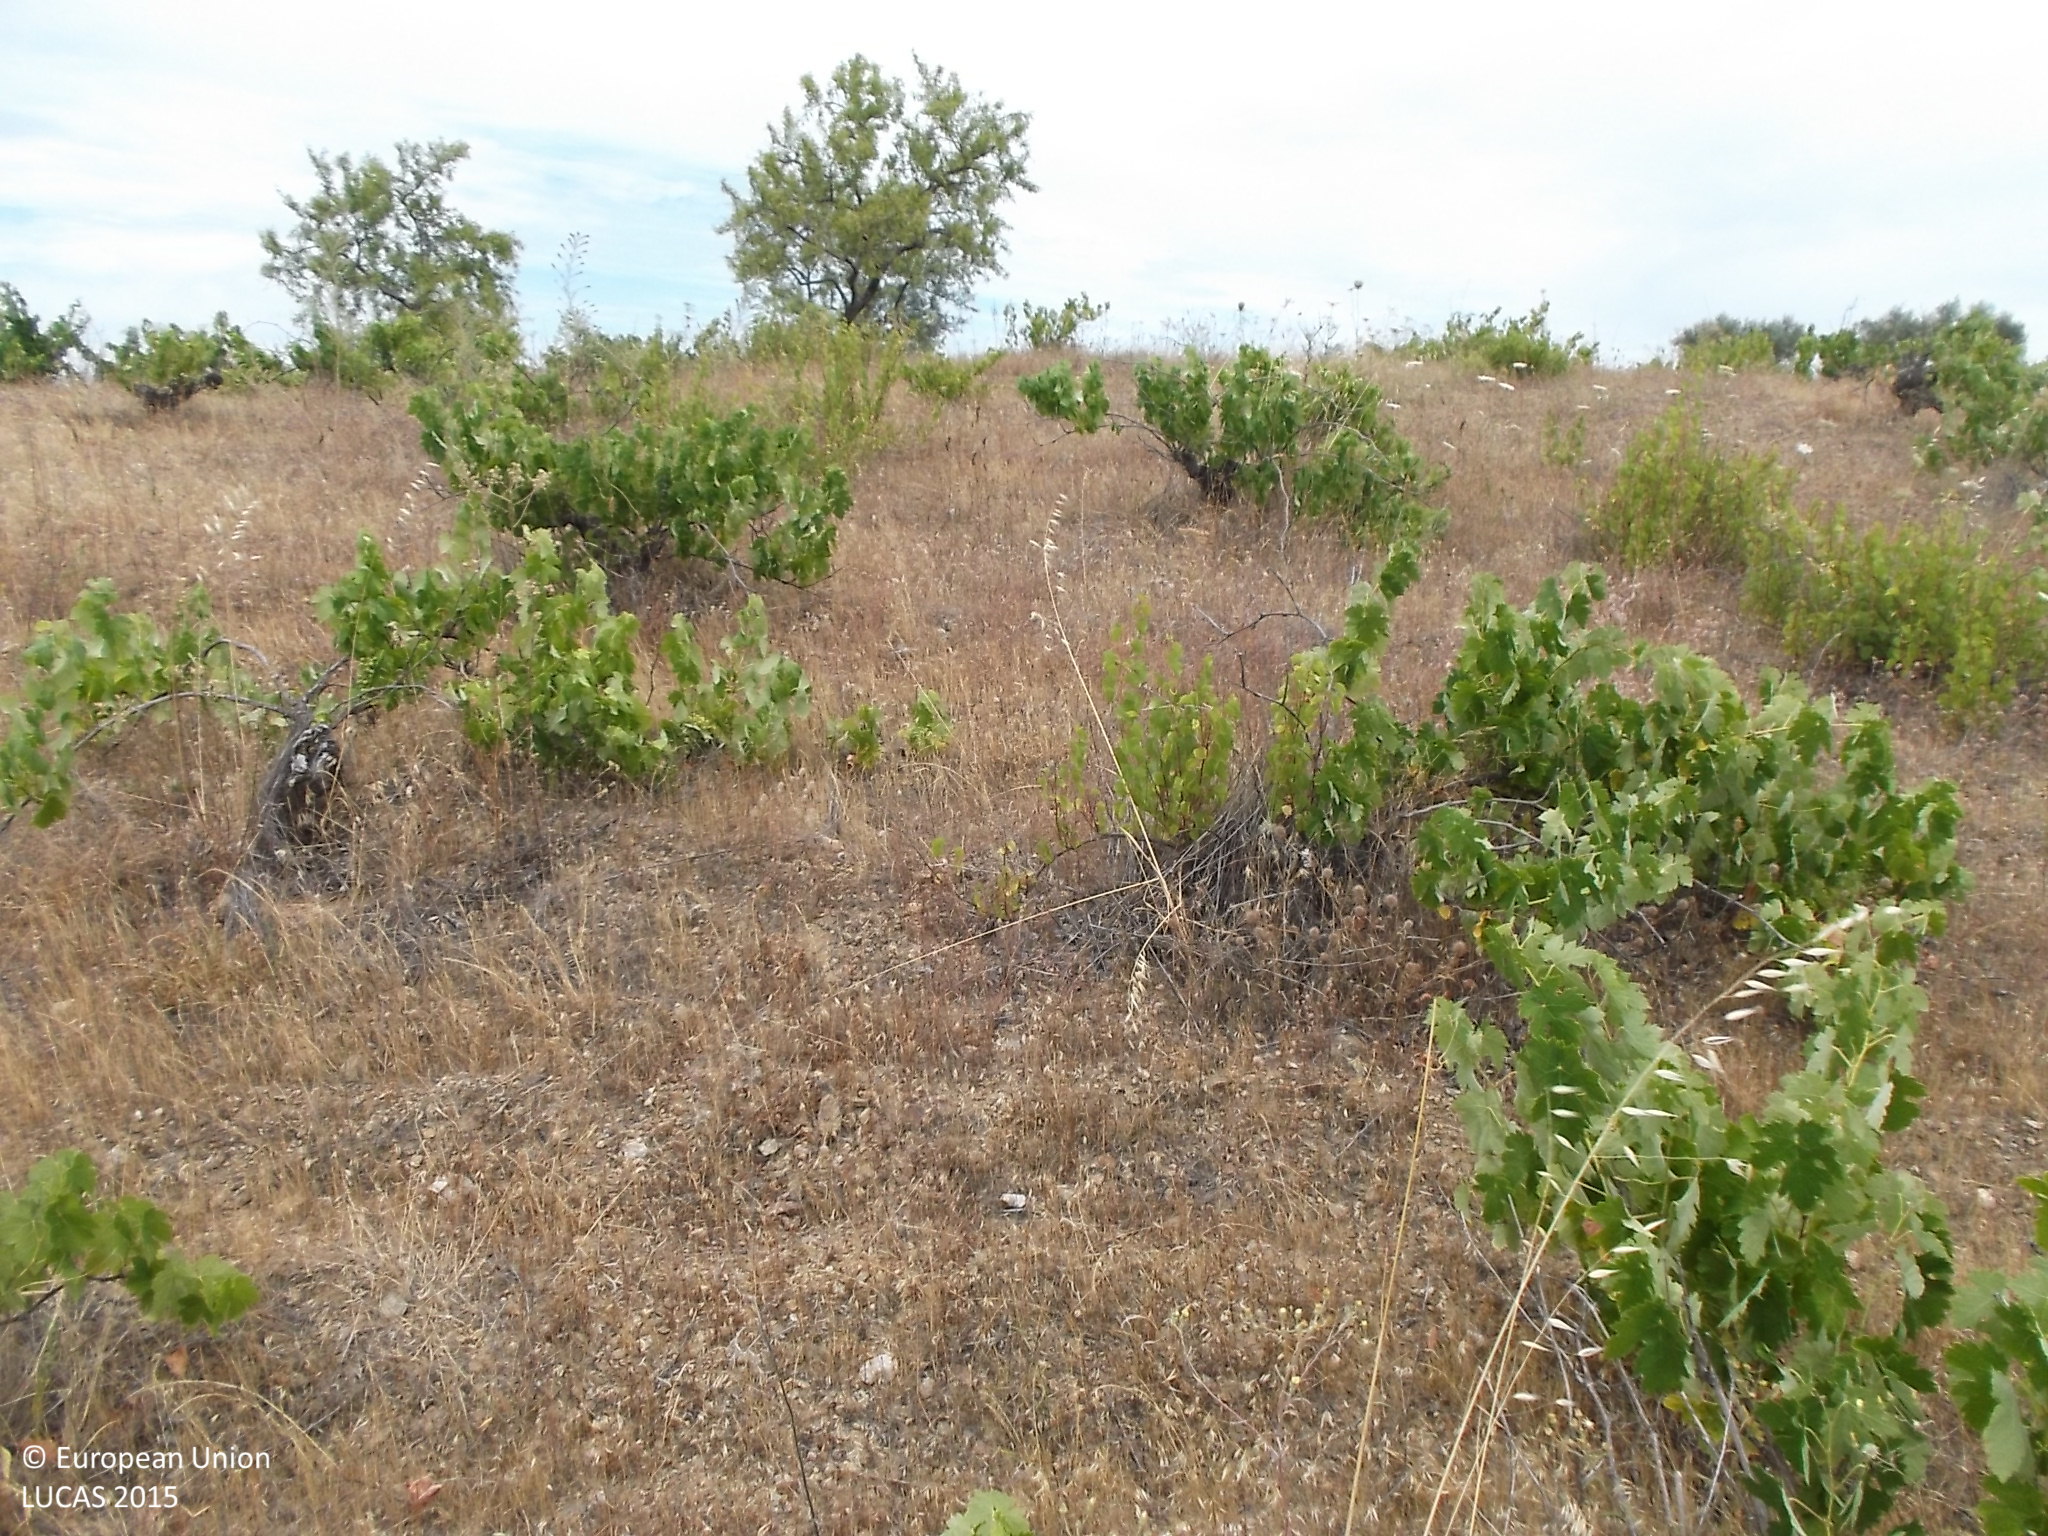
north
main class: Cropland
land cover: Vineyards
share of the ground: 10 - 25 %
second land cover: Spontaneously vegetated surfaces
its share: > 75 %
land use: Agriculture (excluding fallow land and kitchen gardens)
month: July
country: ES
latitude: 41.3064
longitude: -6.4012
